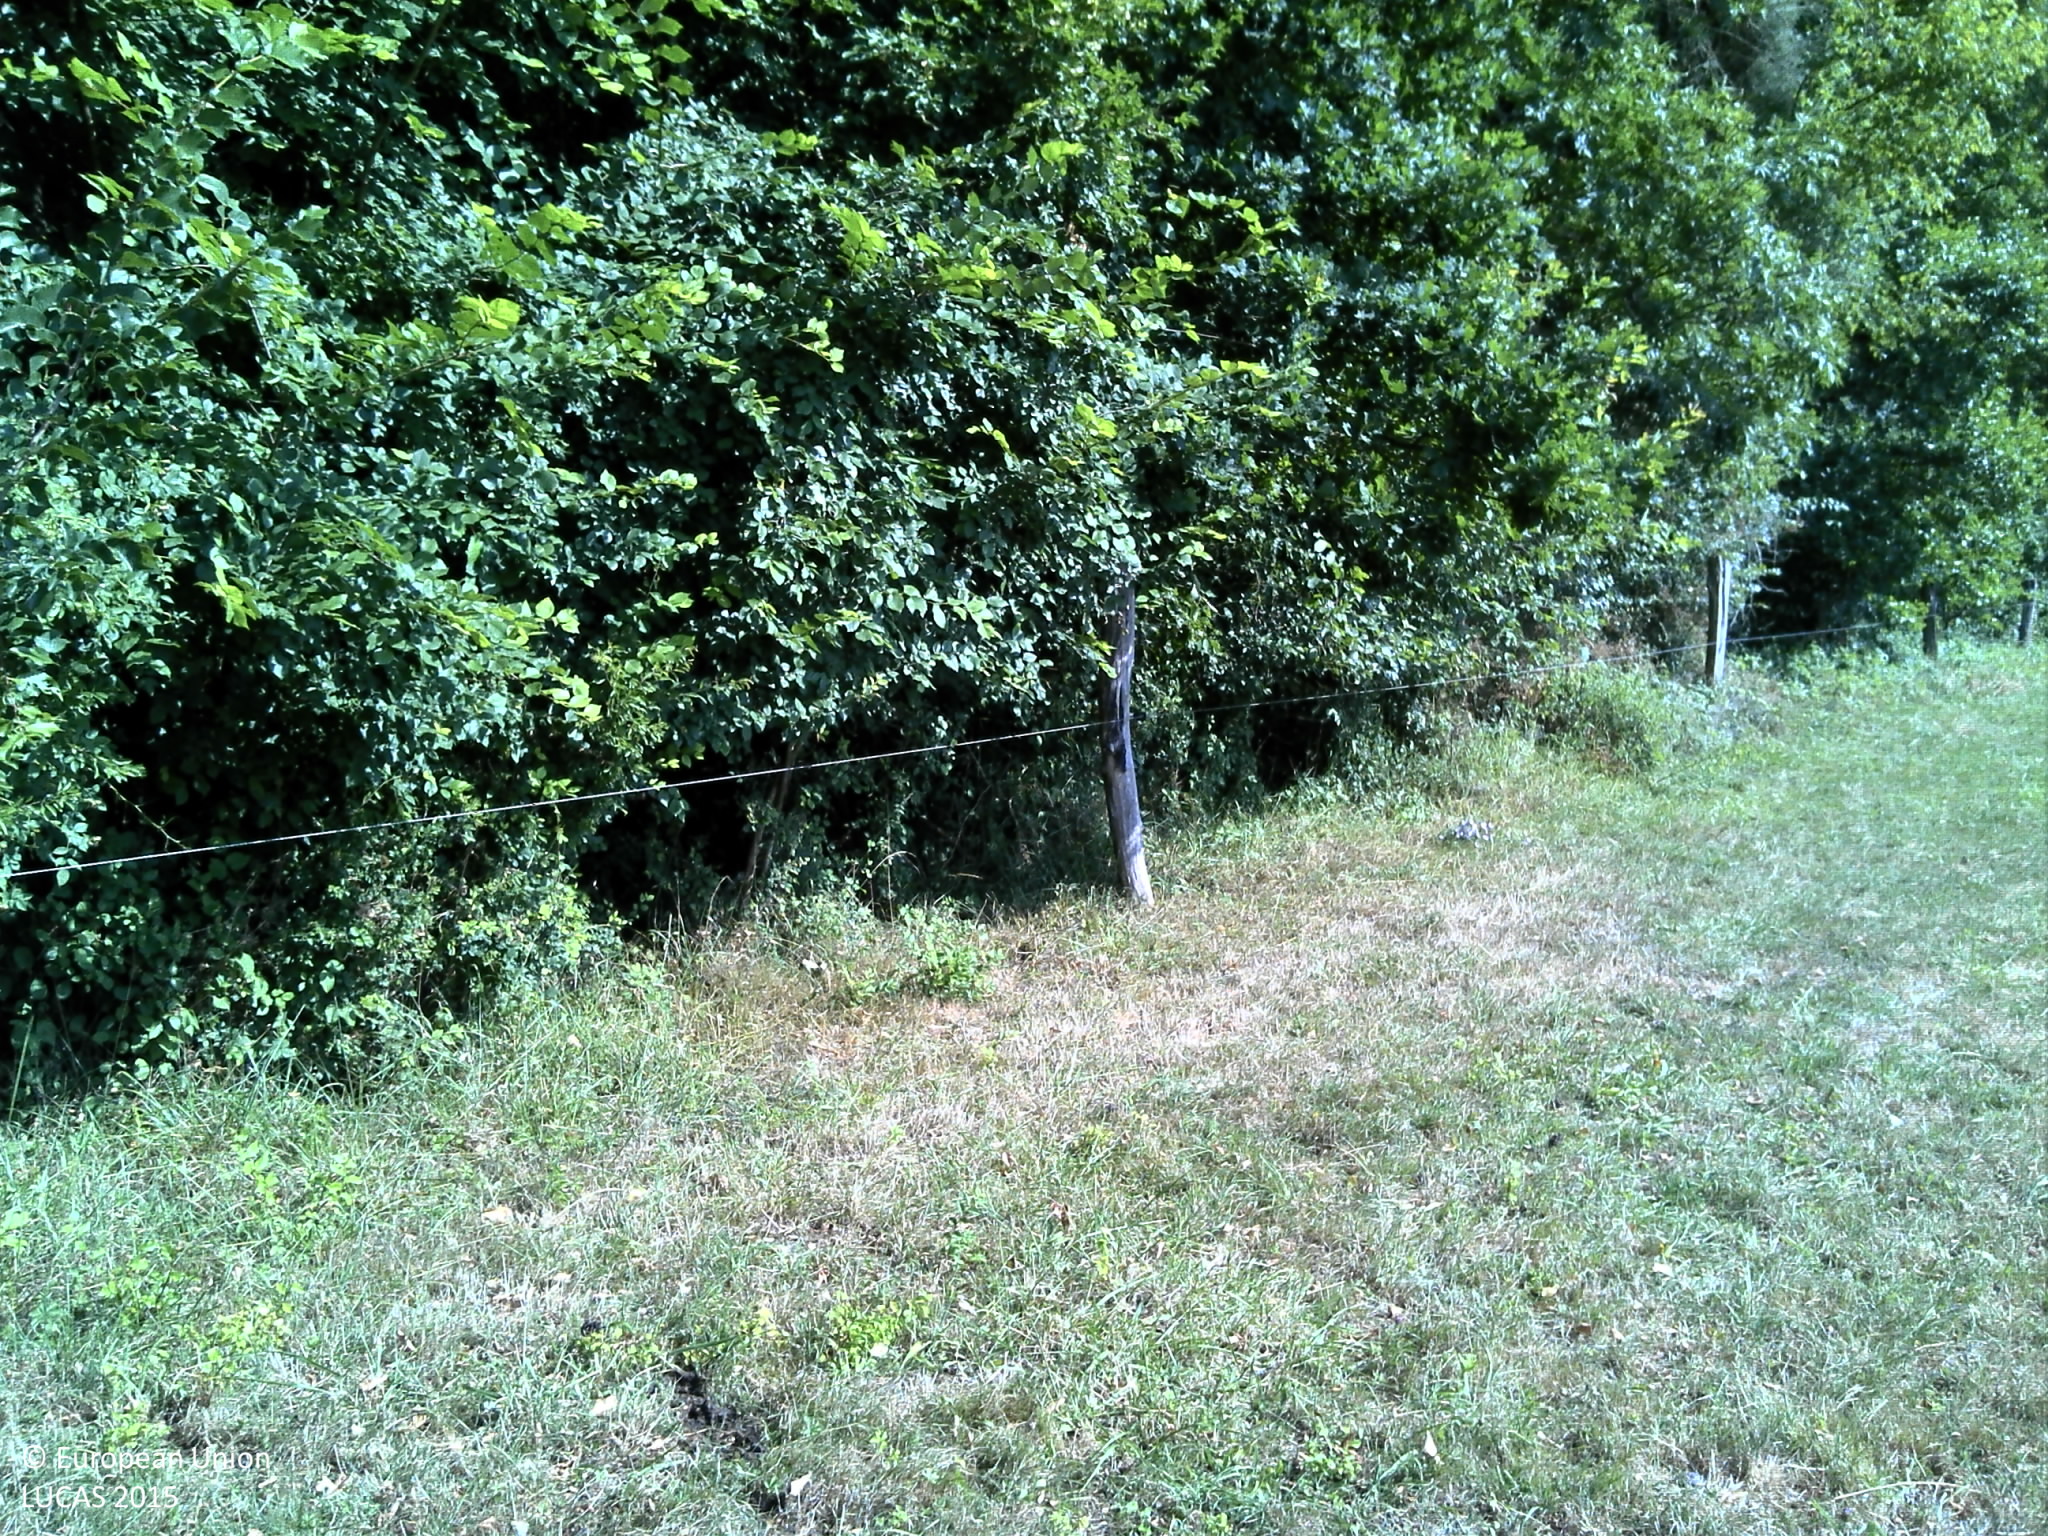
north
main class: Grassland
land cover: Grassland with sparse tree/shrub cover
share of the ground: > 75 %
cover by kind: herbaceous plants 95 %, broadleaved forest trees 5 %
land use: Agriculture (excluding fallow land and kitchen gardens)
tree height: > 5 m
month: July
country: FR
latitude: 48.2137
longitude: 6.2457
